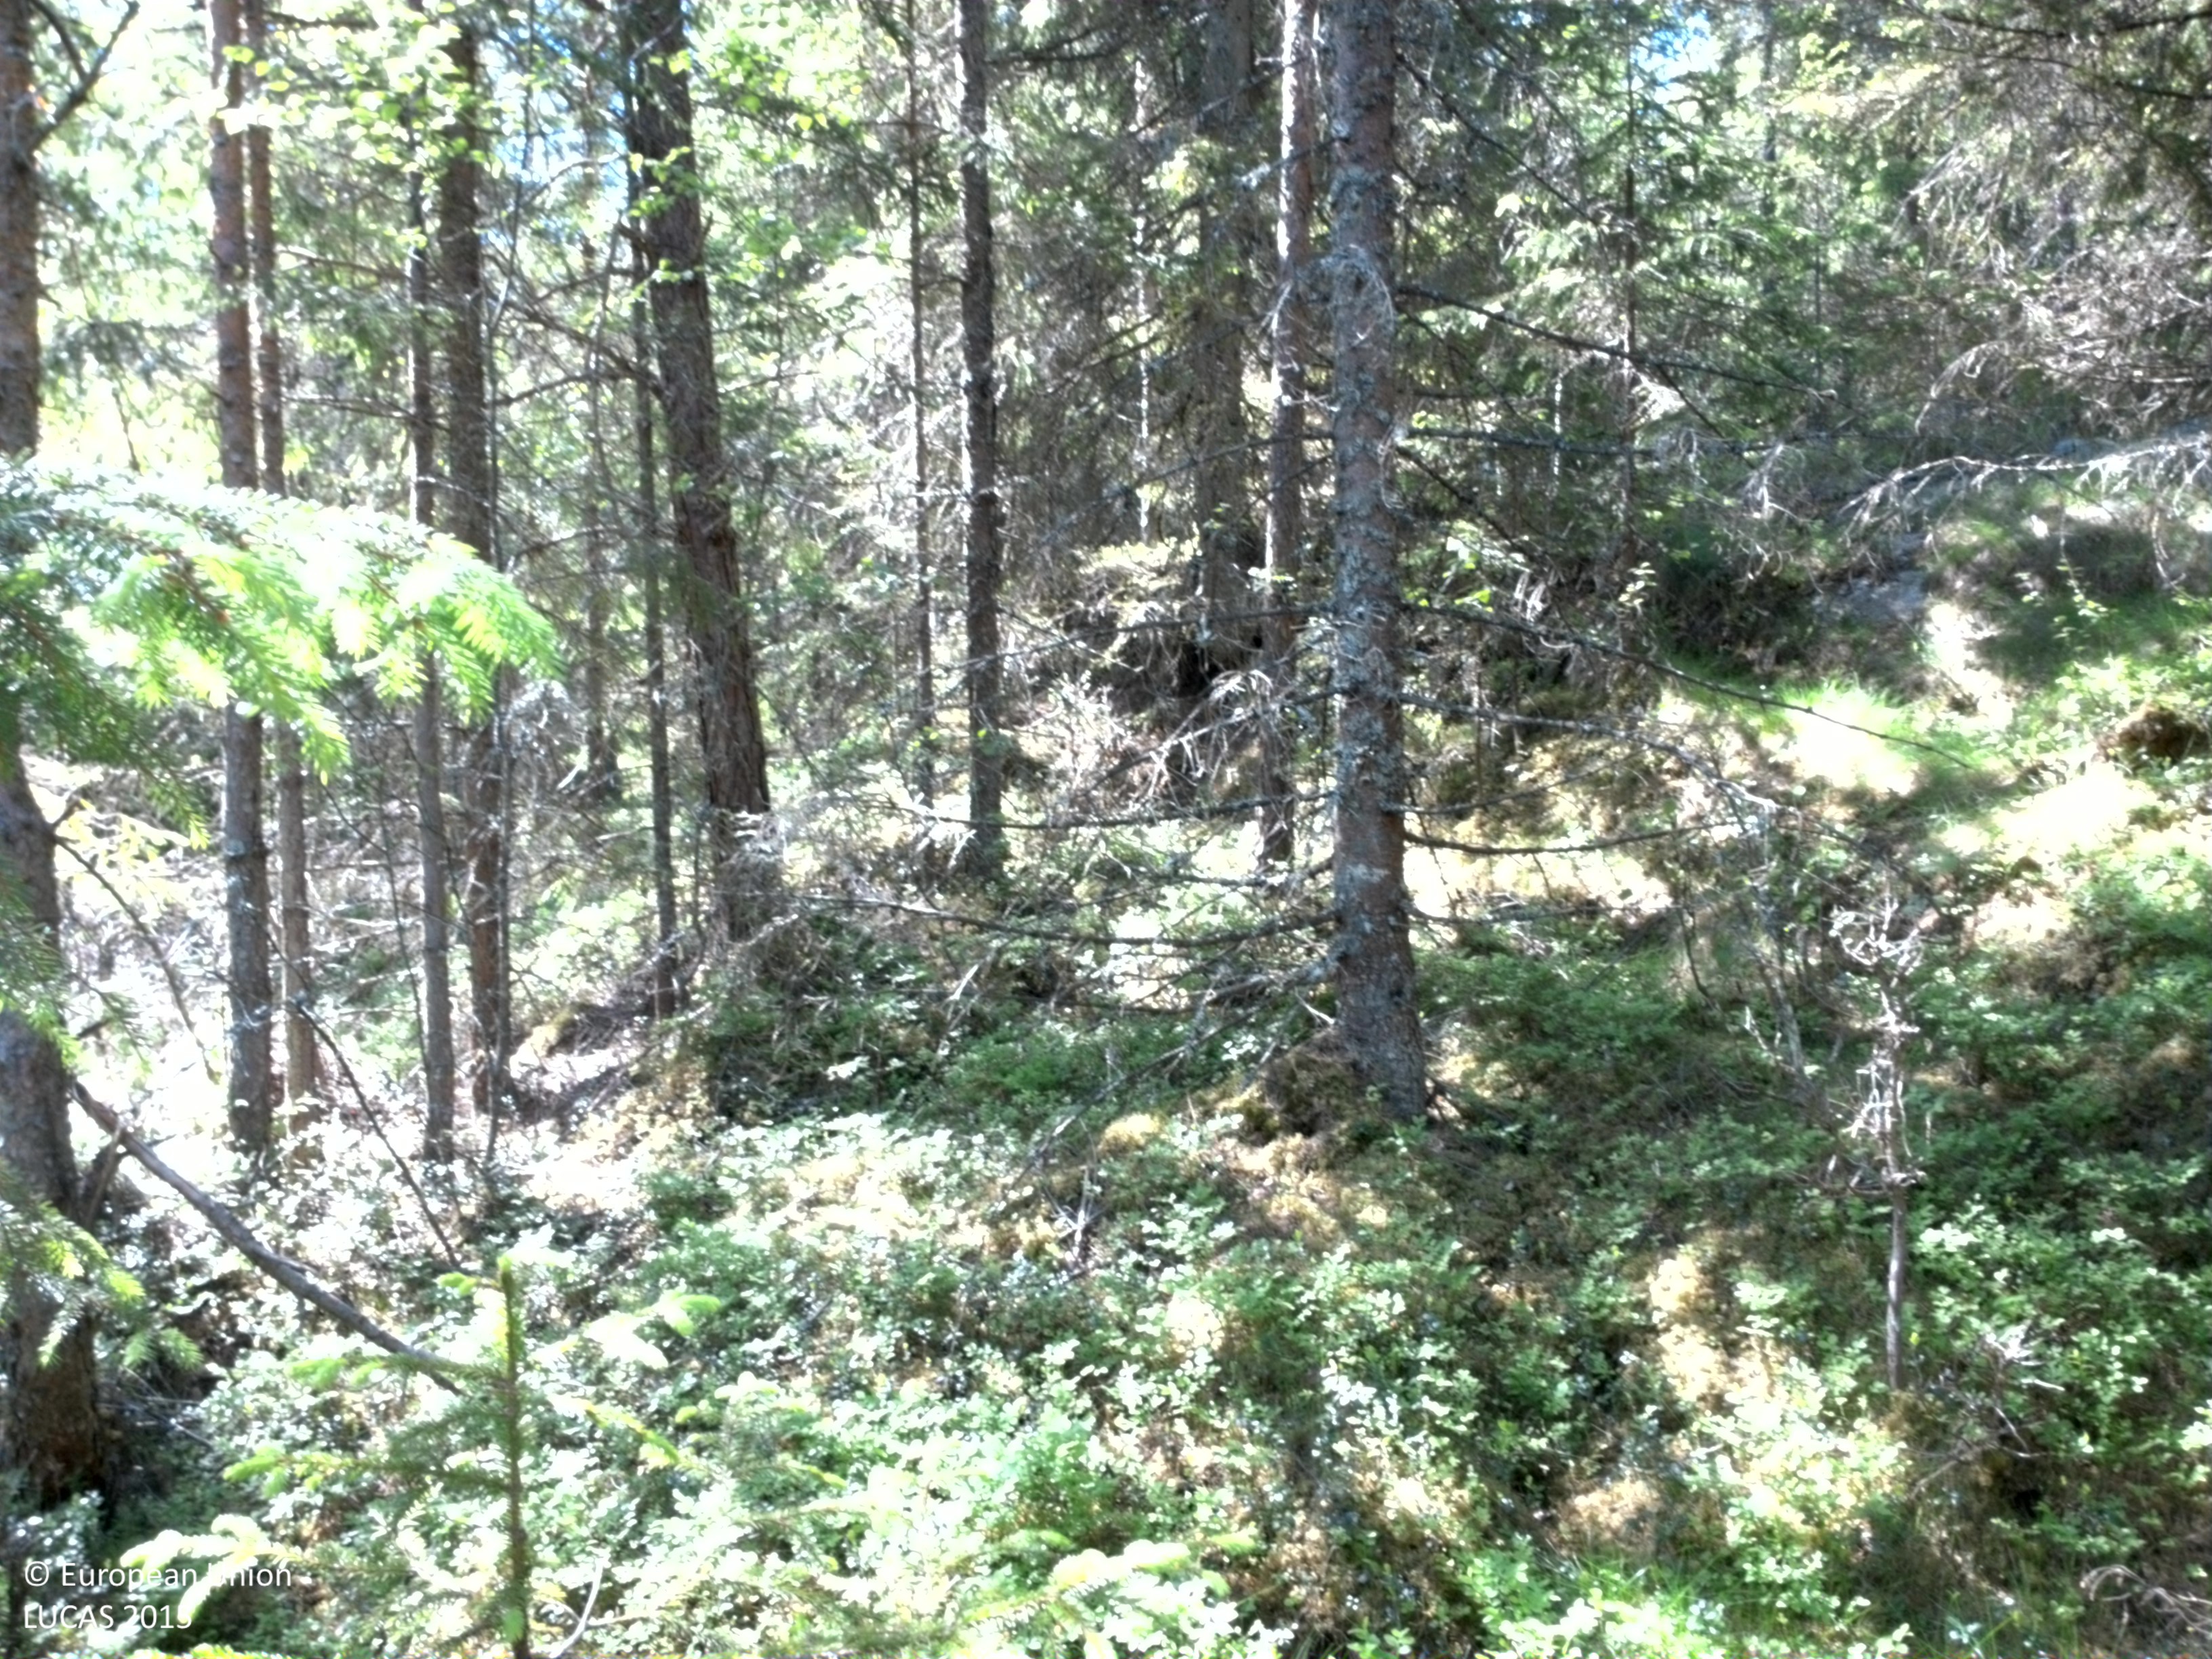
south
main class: Woodland
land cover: Spruce dominated mixed woodland
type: boreal forest
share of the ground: 50 - 75 %
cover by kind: coniferous forest trees 40 %, shrubs 20 %, broadleaved forest trees 15 %, lichens and mosses 15 %, herbaceous plants 10 %
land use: Forestry
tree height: > 5 m
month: June
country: SE
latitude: 59.5184
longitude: 11.9919
